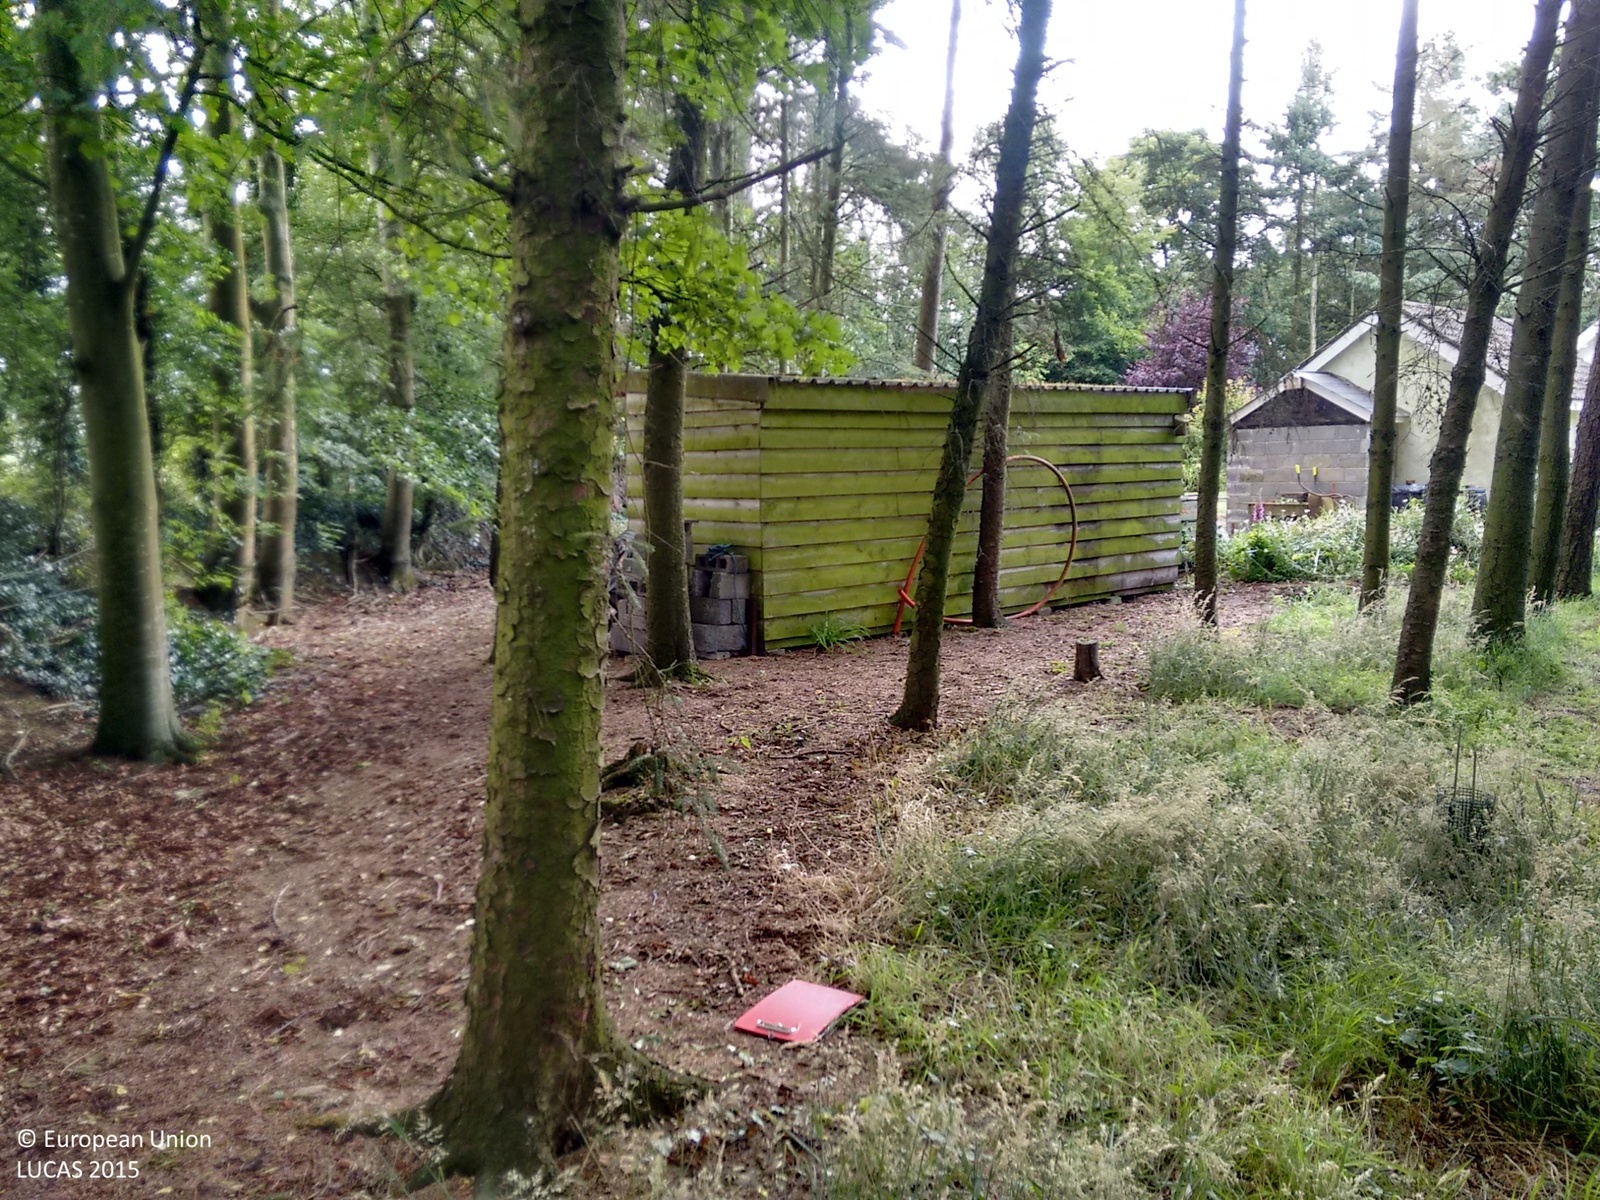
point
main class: Woodland
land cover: Spruce dominated coniferous woodland
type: hemiboreal forest and nemoral coniferous forest and mixed broadleaved-coniferous forest
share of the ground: > 75 %
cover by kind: coniferous forest trees 85 %, broadleaved forest trees 10 %, shrubs 5 %
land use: Residential
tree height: > 5 m
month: July
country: IE
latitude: 52.8265
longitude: -6.7725
